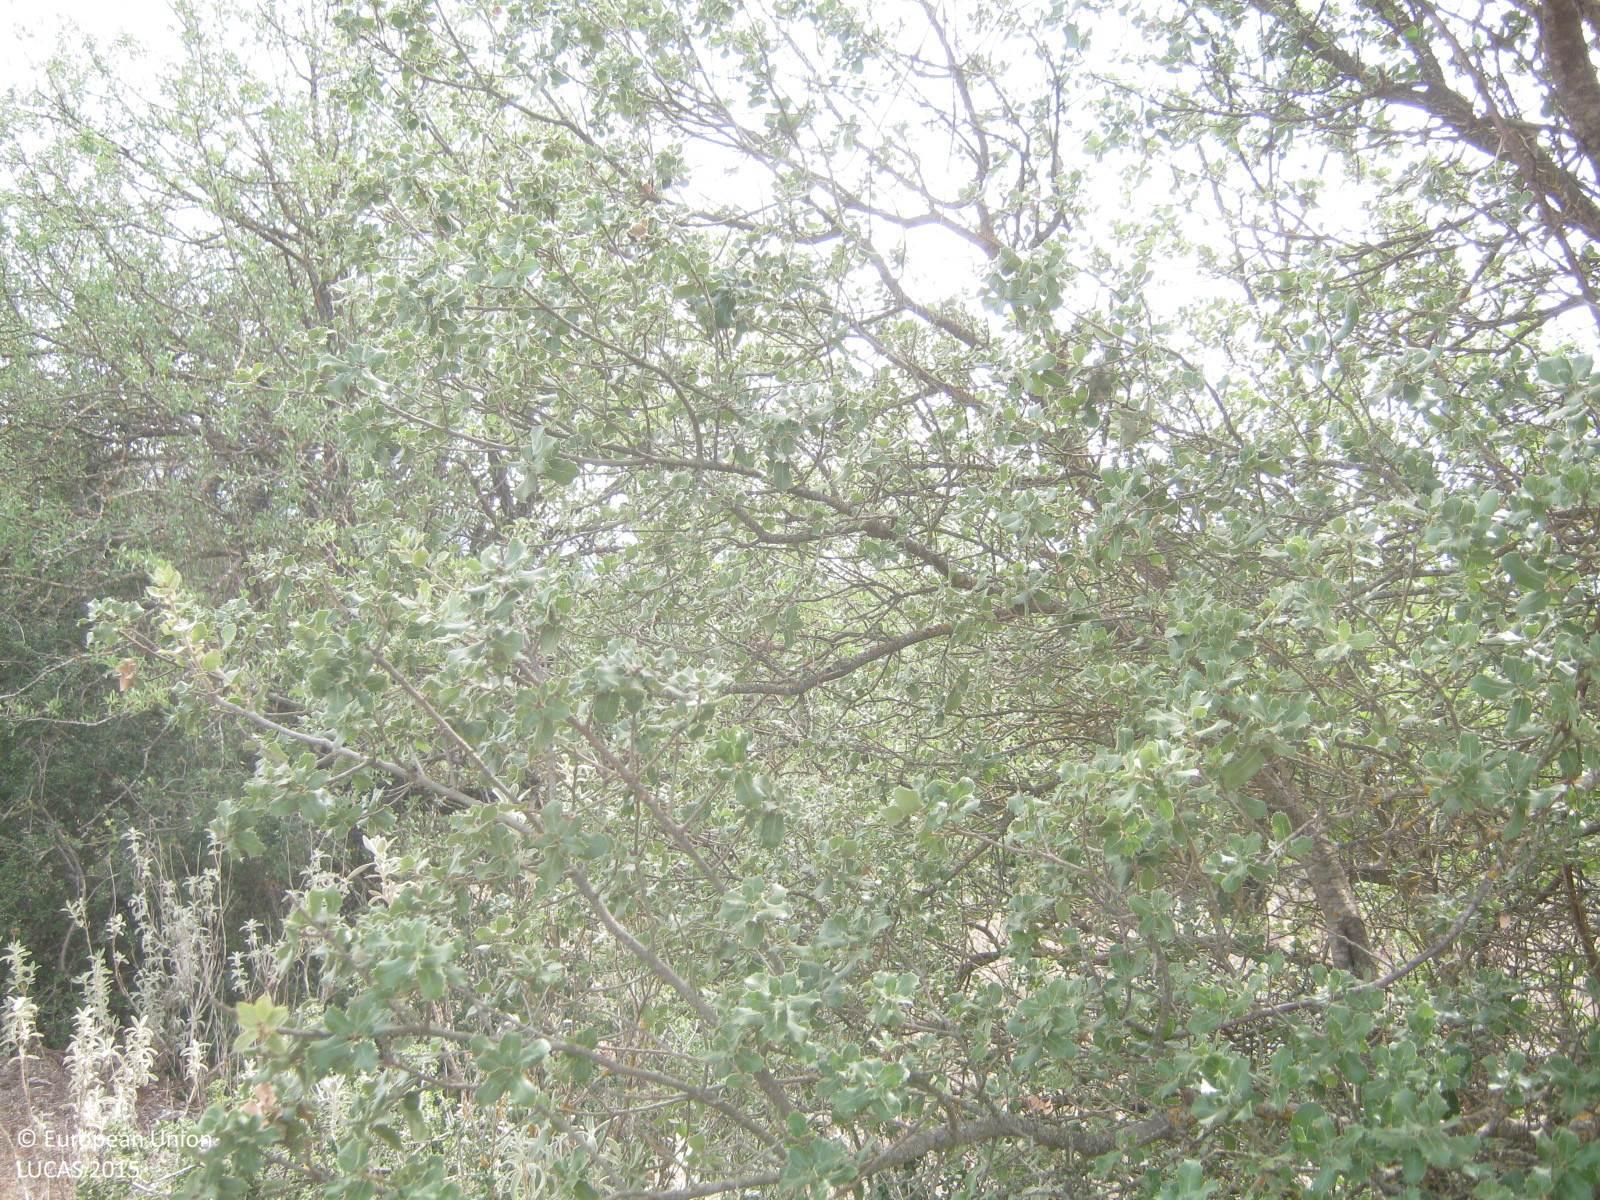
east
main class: Grassland
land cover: Grassland with sparse tree/shrub cover
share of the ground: 50 - 75 %
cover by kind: herbaceous plants 50 %, unconsolidated bare surface 35 %, shrubs 10 %, broadleaved forest trees 5 %
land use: Agriculture (excluding fallow land and kitchen gardens)
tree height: < 5 m
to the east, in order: Grassland with sparse tree/shrub cover; Shrubland without tree cover; Grassland with sparse tree/shrub cover; Tracks; Fences; Grassland with sparse tree/shrub cover; Dry stone walls; Grassland with sparse tree/shrub cover; Shrubland with sparse tree cover; Dry stone walls; Shrubland with sparse tree cover; Other bare soil; Abandoned hedges; Dry stone walls; Tracks; Abandoned hedges; Dry stone walls; Grassland with sparse tree/shrub cover; Shrubland with sparse tree cover; Grassland with sparse tree/shrub cover
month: September
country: GR
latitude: 37.8370
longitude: 22.0657
